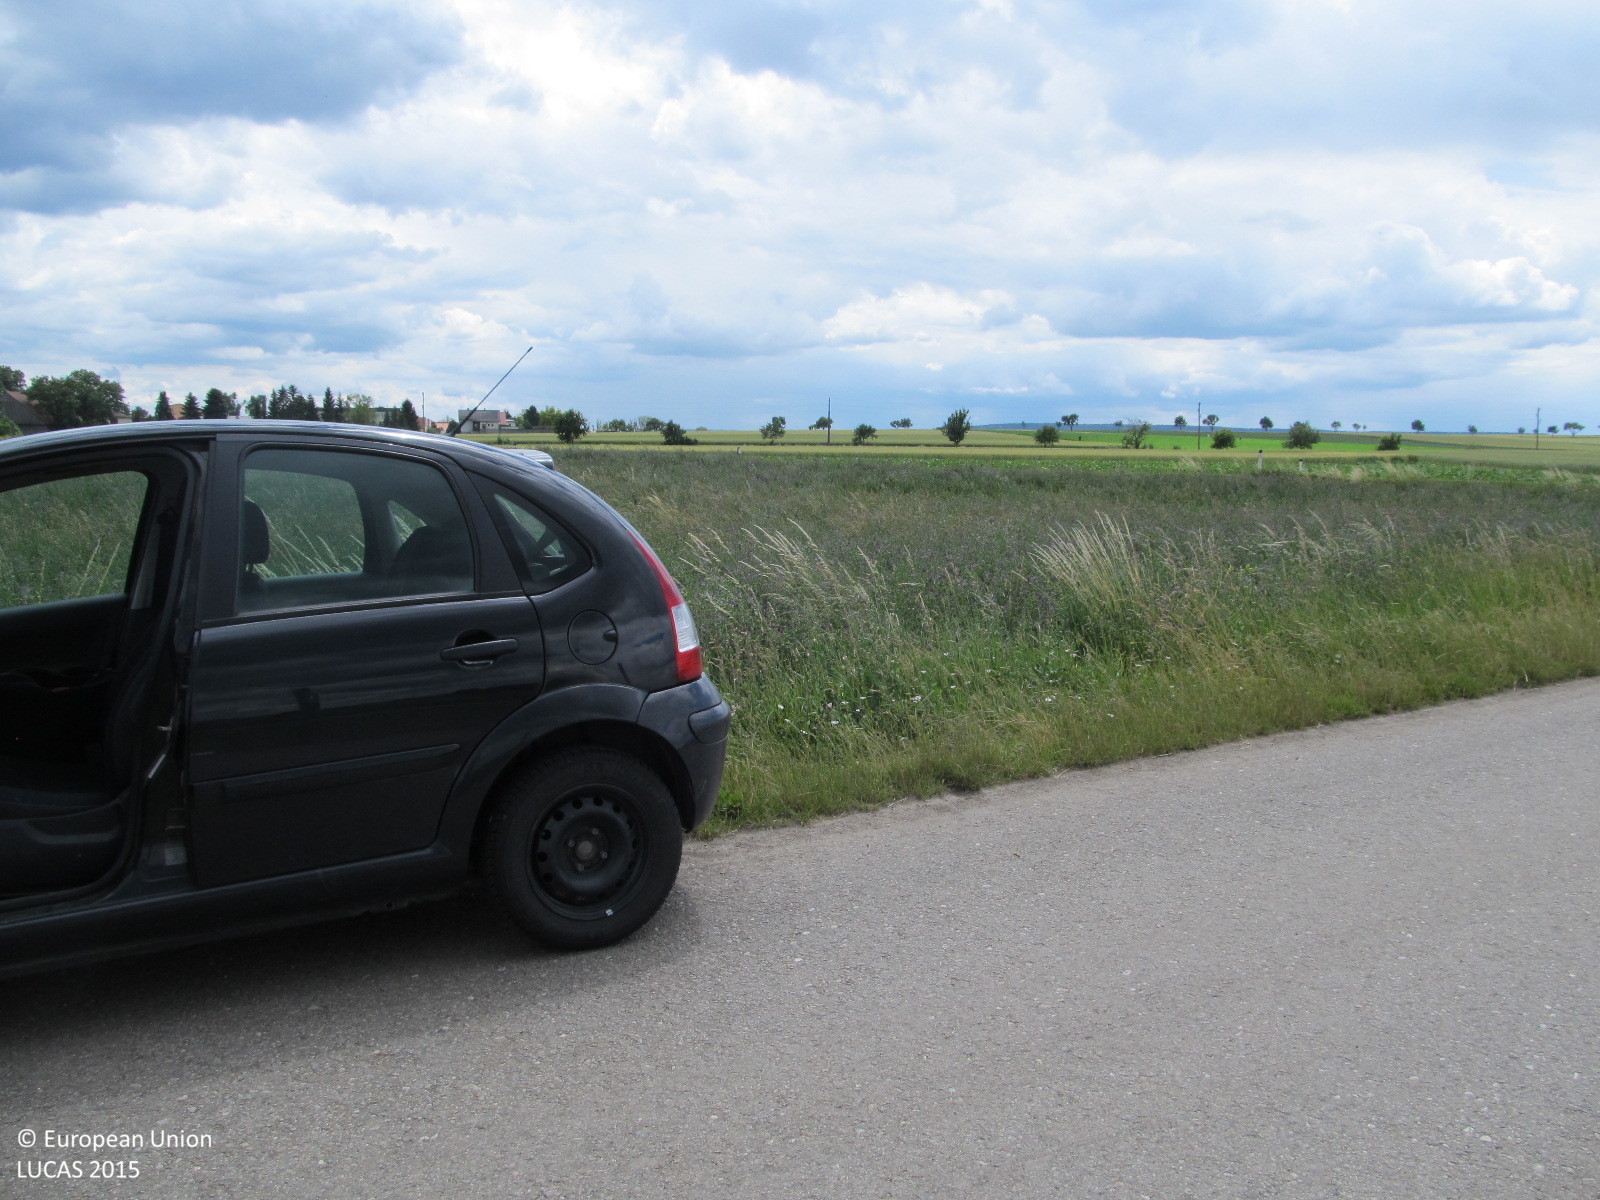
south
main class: Grassland
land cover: Grassland without tree/shrub cover
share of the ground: > 75 %
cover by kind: herbaceous plants 100 %
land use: Agriculture (excluding fallow land and kitchen gardens)
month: June
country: AT
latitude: 48.6322
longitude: 16.0972
